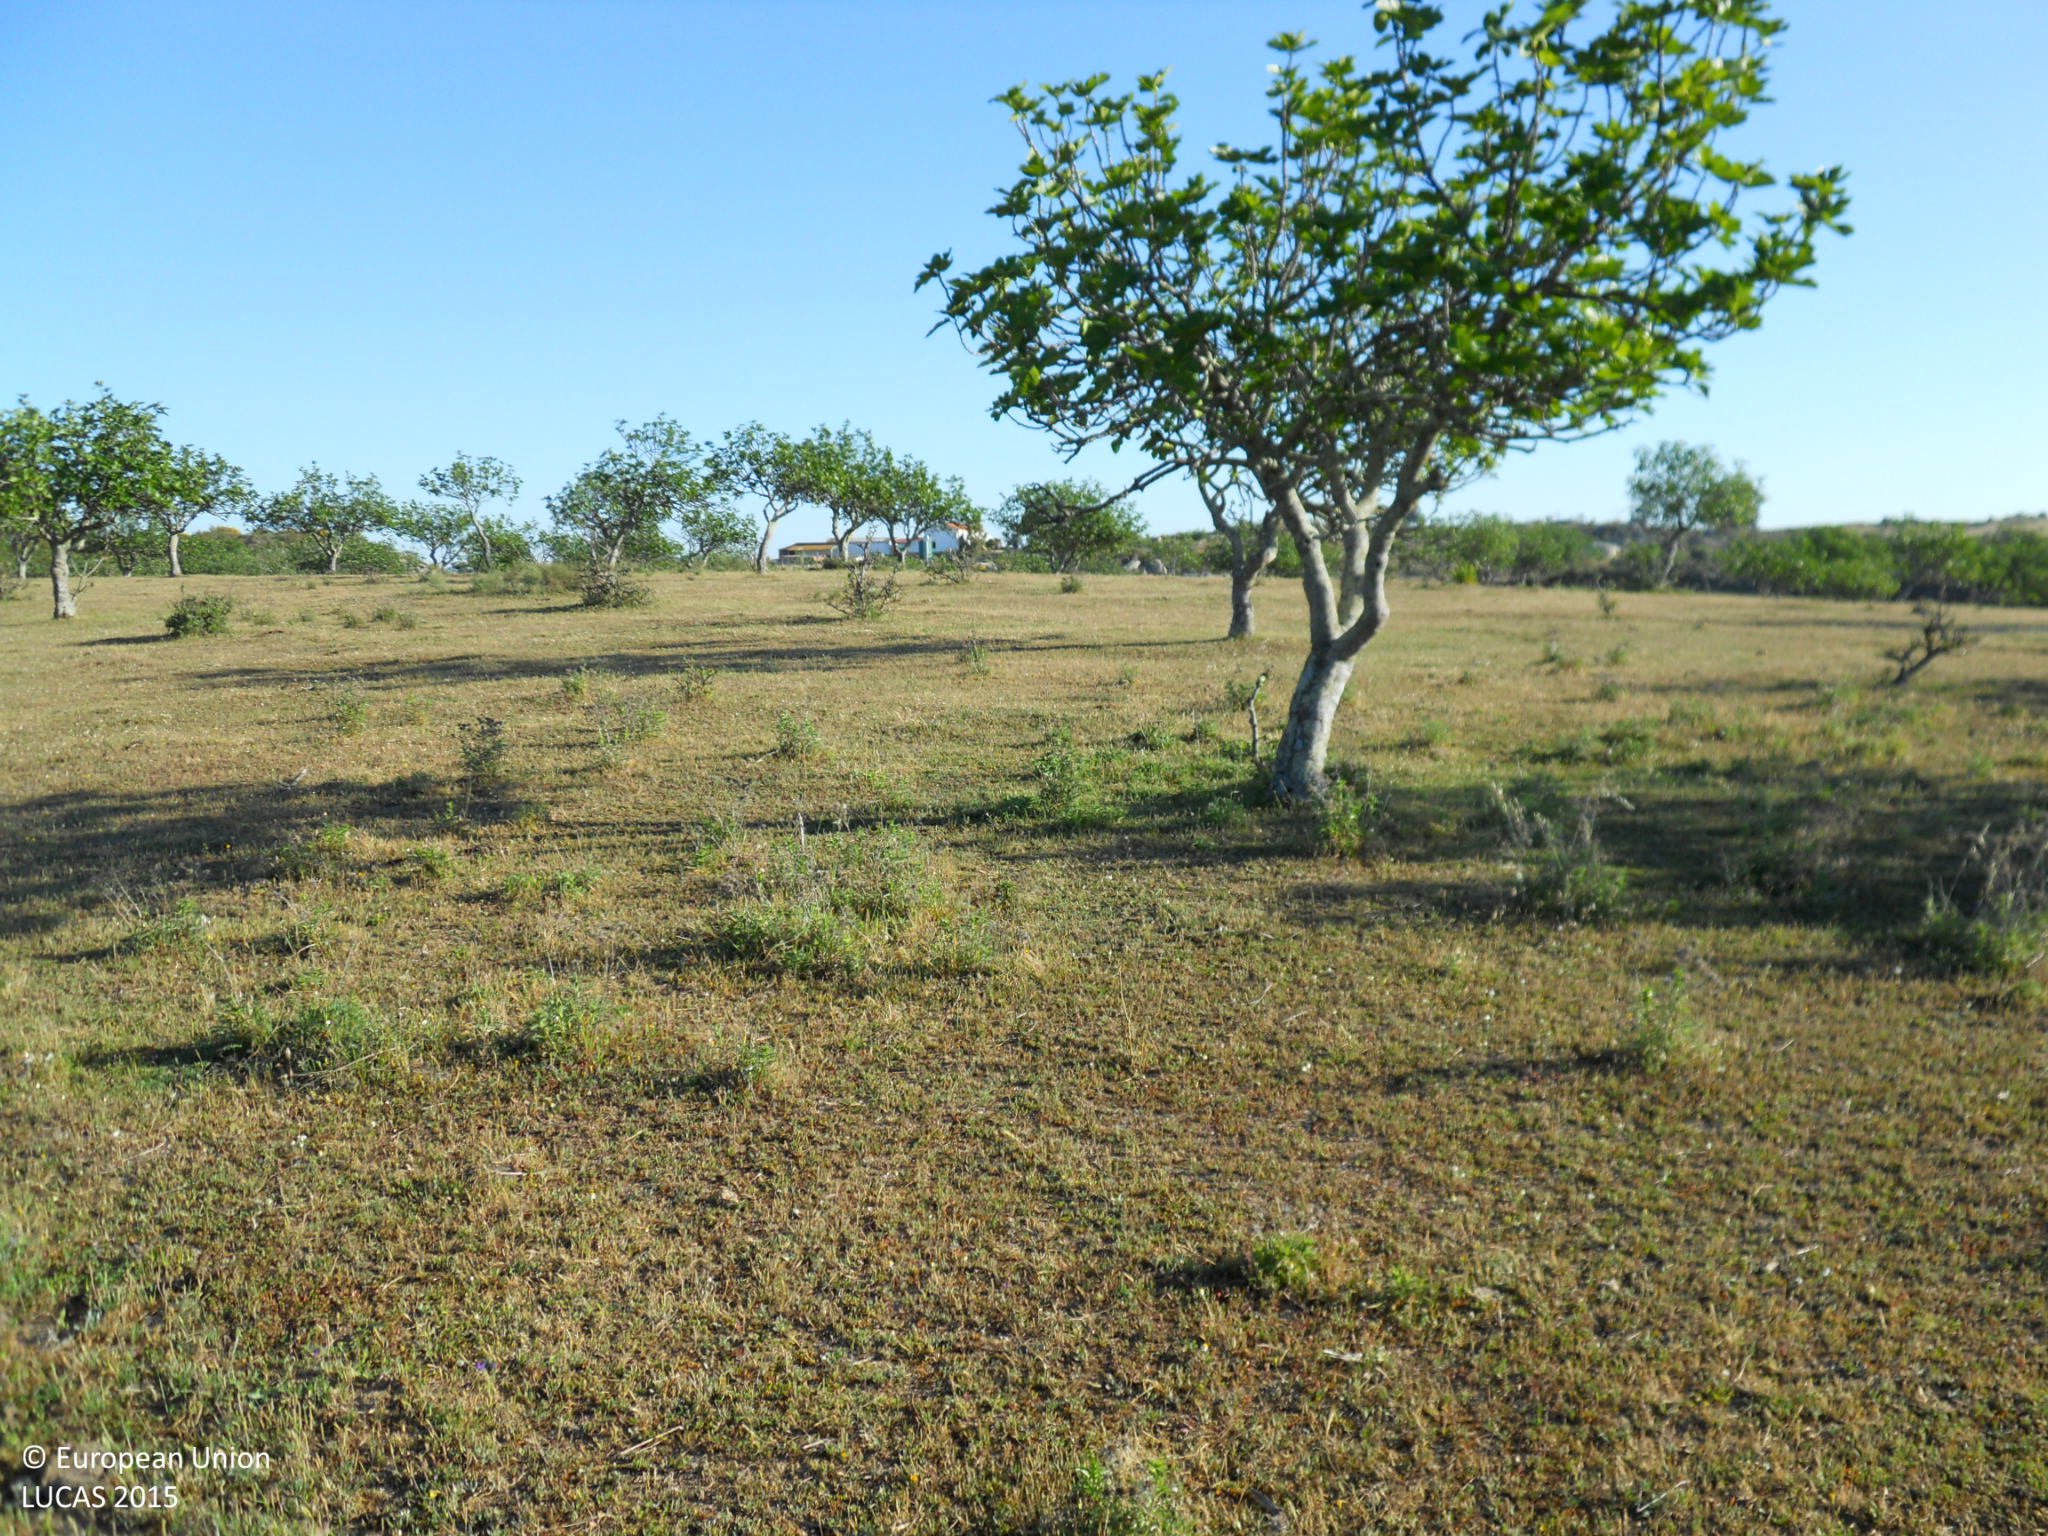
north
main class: Cropland
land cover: Other fruit trees and berries
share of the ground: 25 - 50 %
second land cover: Spontaneously vegetated surfaces
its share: > 75 %
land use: Agriculture (excluding fallow land and kitchen gardens)
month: April
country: ES
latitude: 39.2849
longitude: -7.0161
